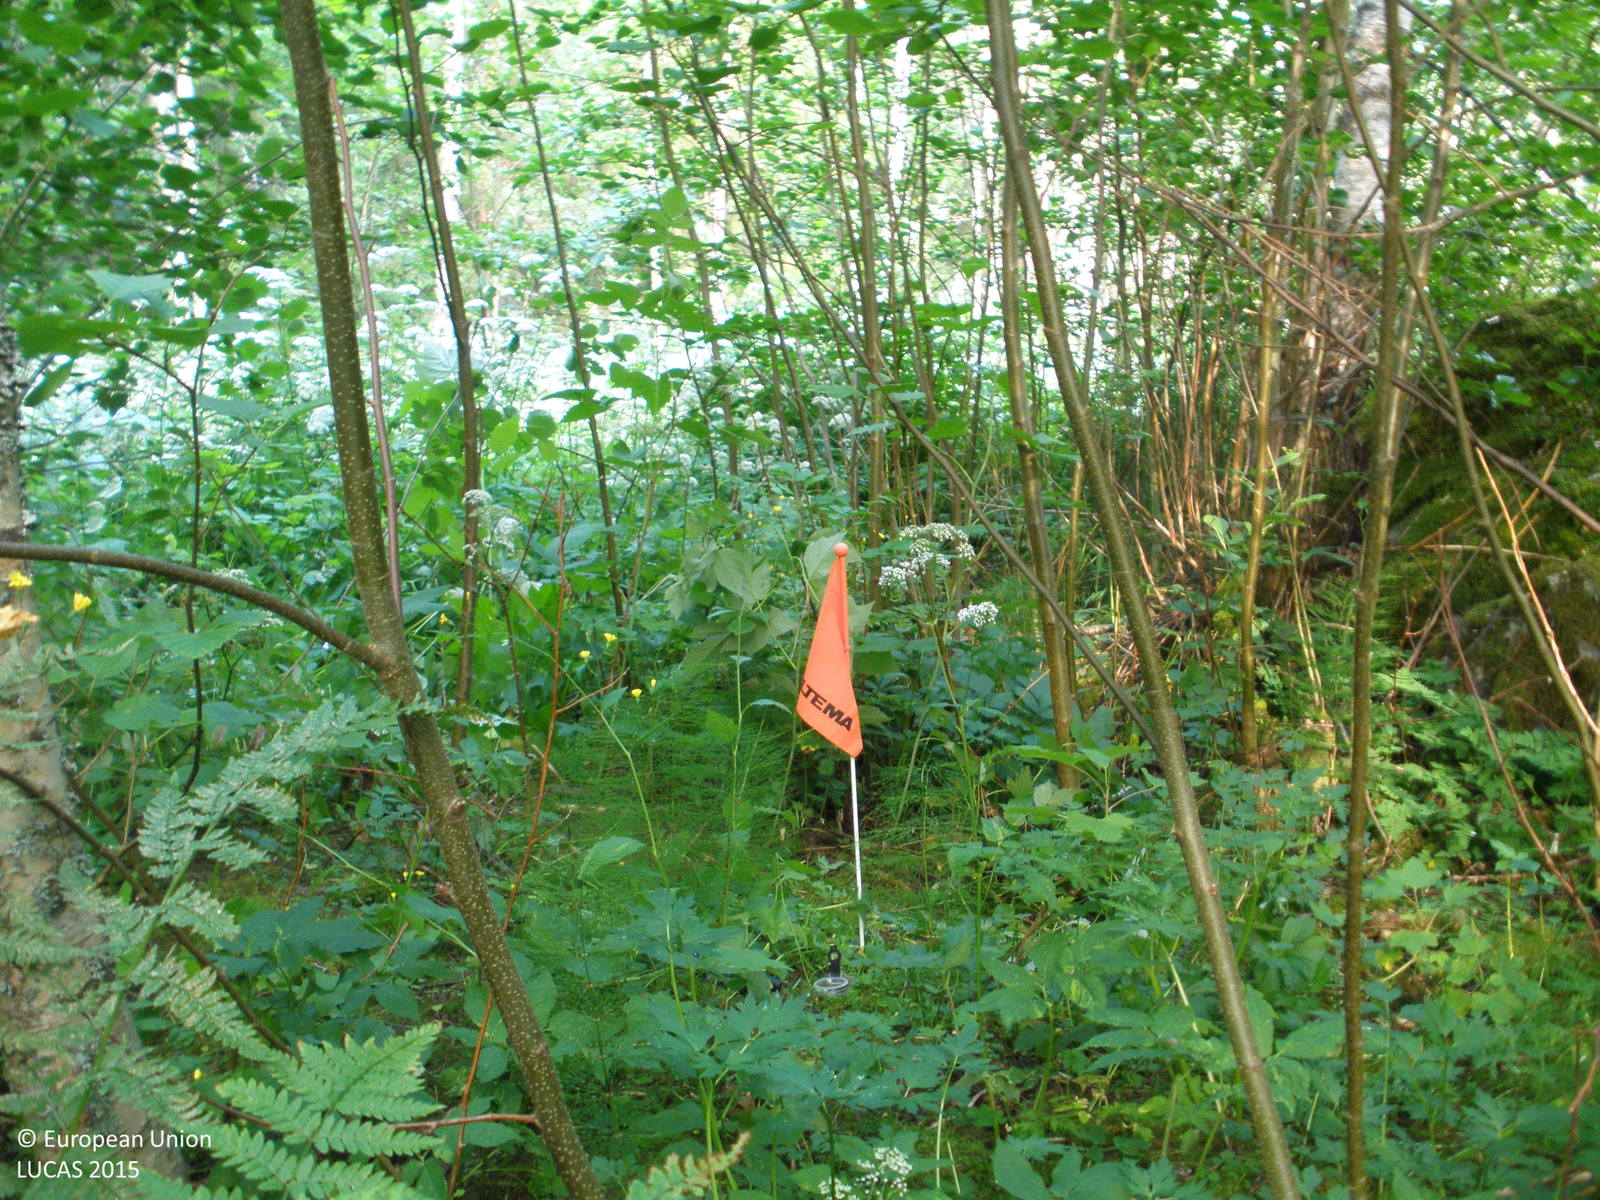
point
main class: Woodland
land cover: Broadleaved woodland
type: non-riverine alder, birch or aspen forest
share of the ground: > 75 %
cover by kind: broadleaved forest trees 85 %, shrubs 10 %, herbaceous plants 5 %
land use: Forestry
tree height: > 5 m
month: July
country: FI
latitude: 61.4027
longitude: 24.0045
